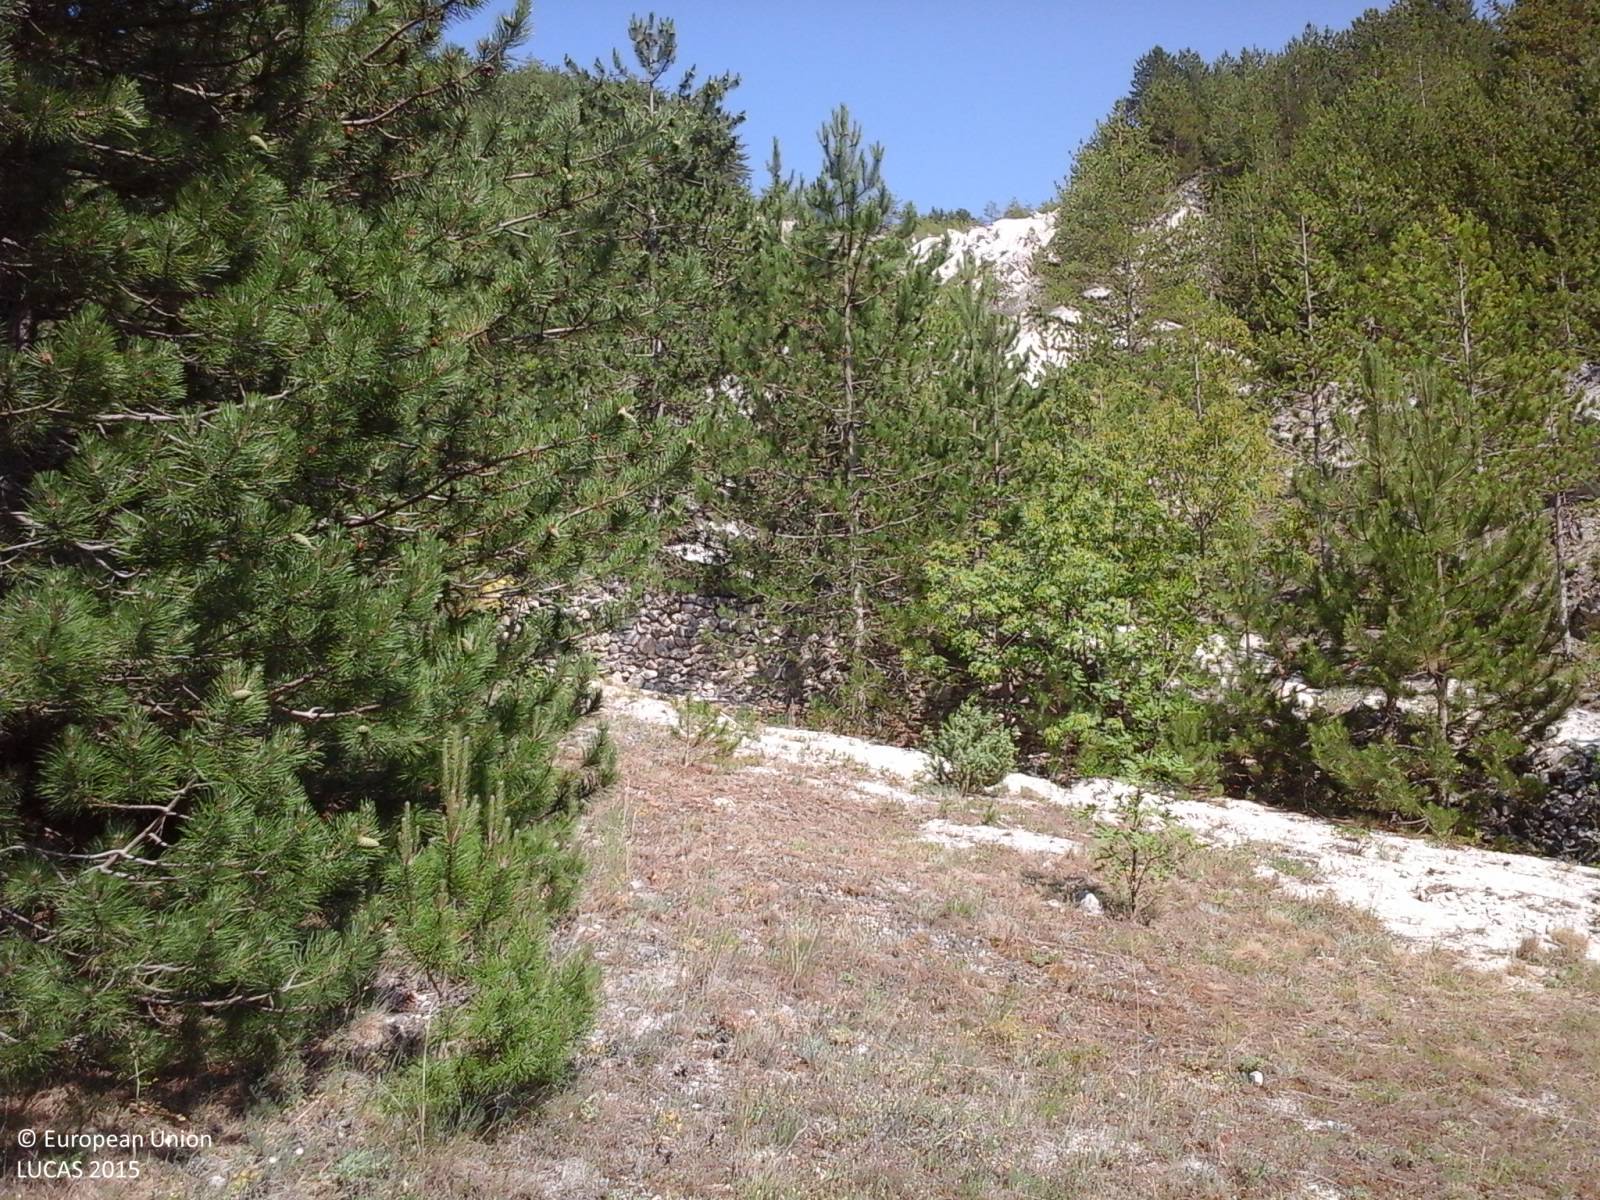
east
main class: Woodland
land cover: Pine dominated coniferous woodland
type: coniferous forest of the mediterranean region
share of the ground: 25 - 50 %
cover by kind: herbaceous plants 55 %, coniferous forest trees 35 %, unconsolidated bare surface 10 %
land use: Forestry
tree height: > 5 m
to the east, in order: Pine dominated coniferous woodland; Dry stone walls; Tracks; Pine dominated coniferous woodland
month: July
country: IT
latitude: 42.4365
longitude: 13.3324
